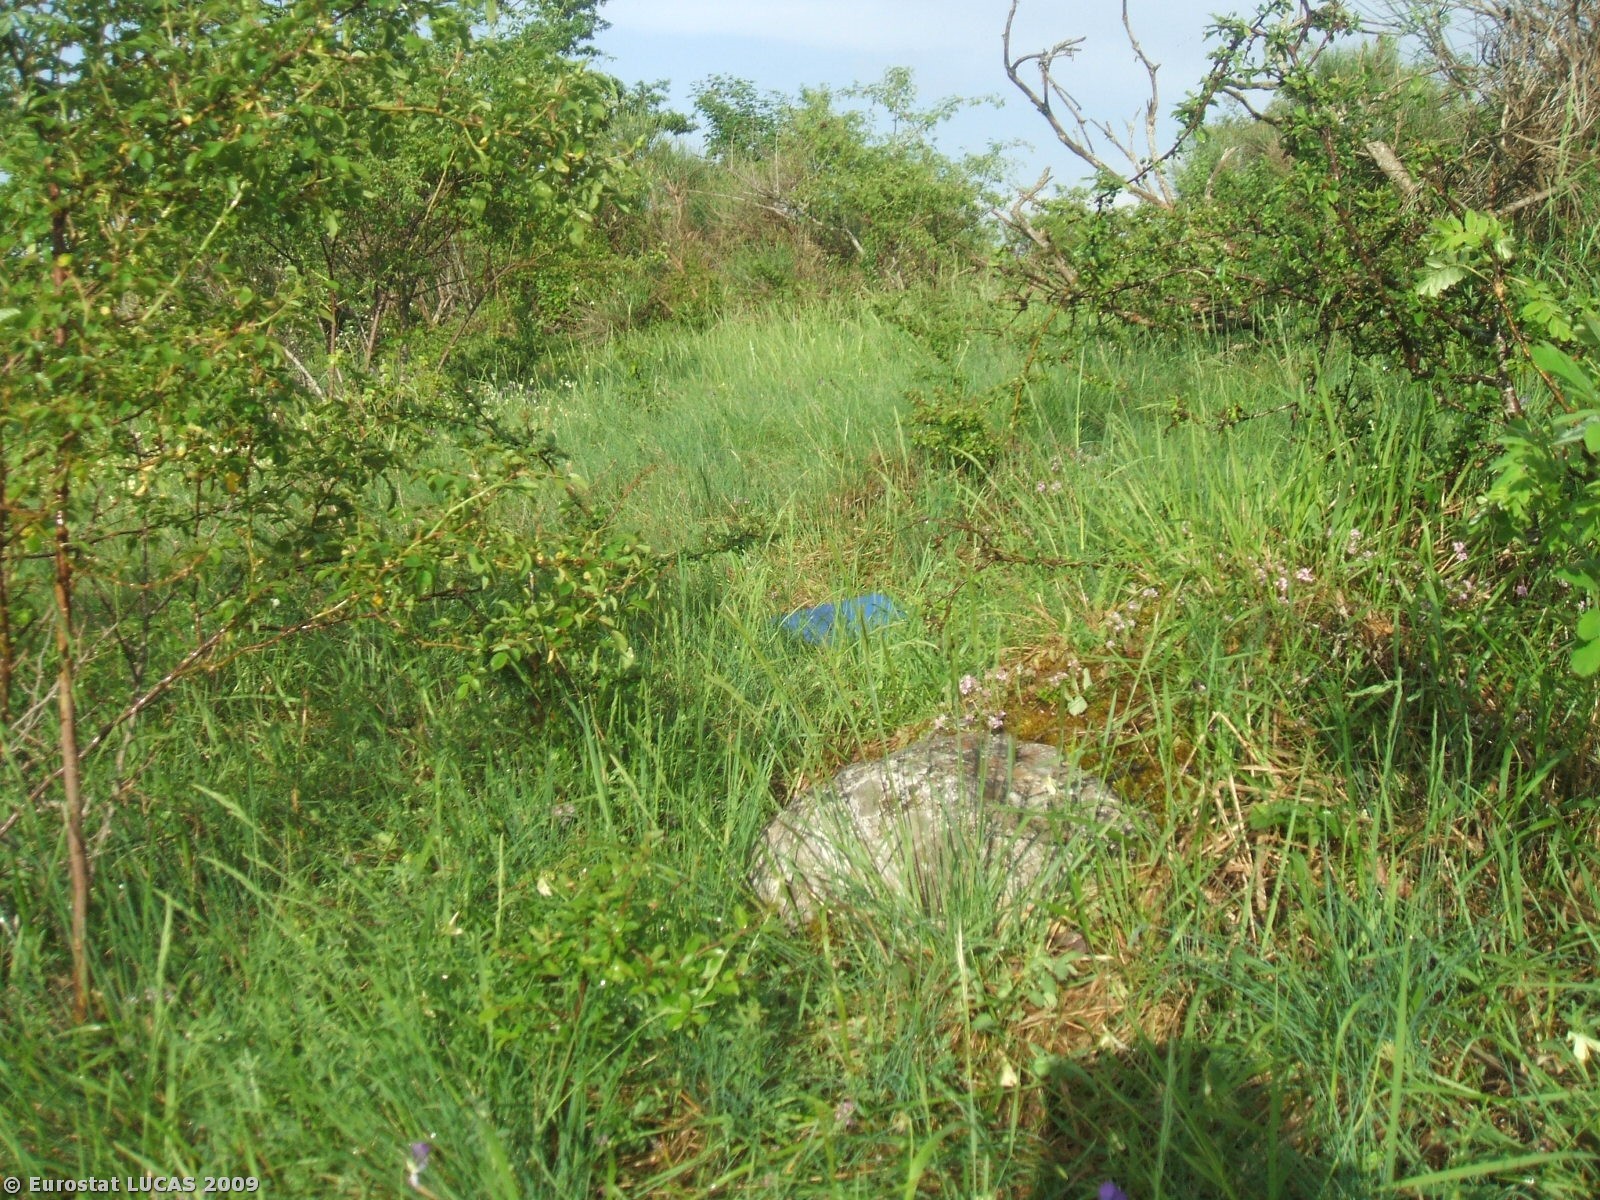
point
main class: Shrubland
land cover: Shrubland with sparse tree cover
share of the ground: > 75 %
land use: Fallow land
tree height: < 5 m
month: May
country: IT
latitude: 40.2772
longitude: 15.7975
